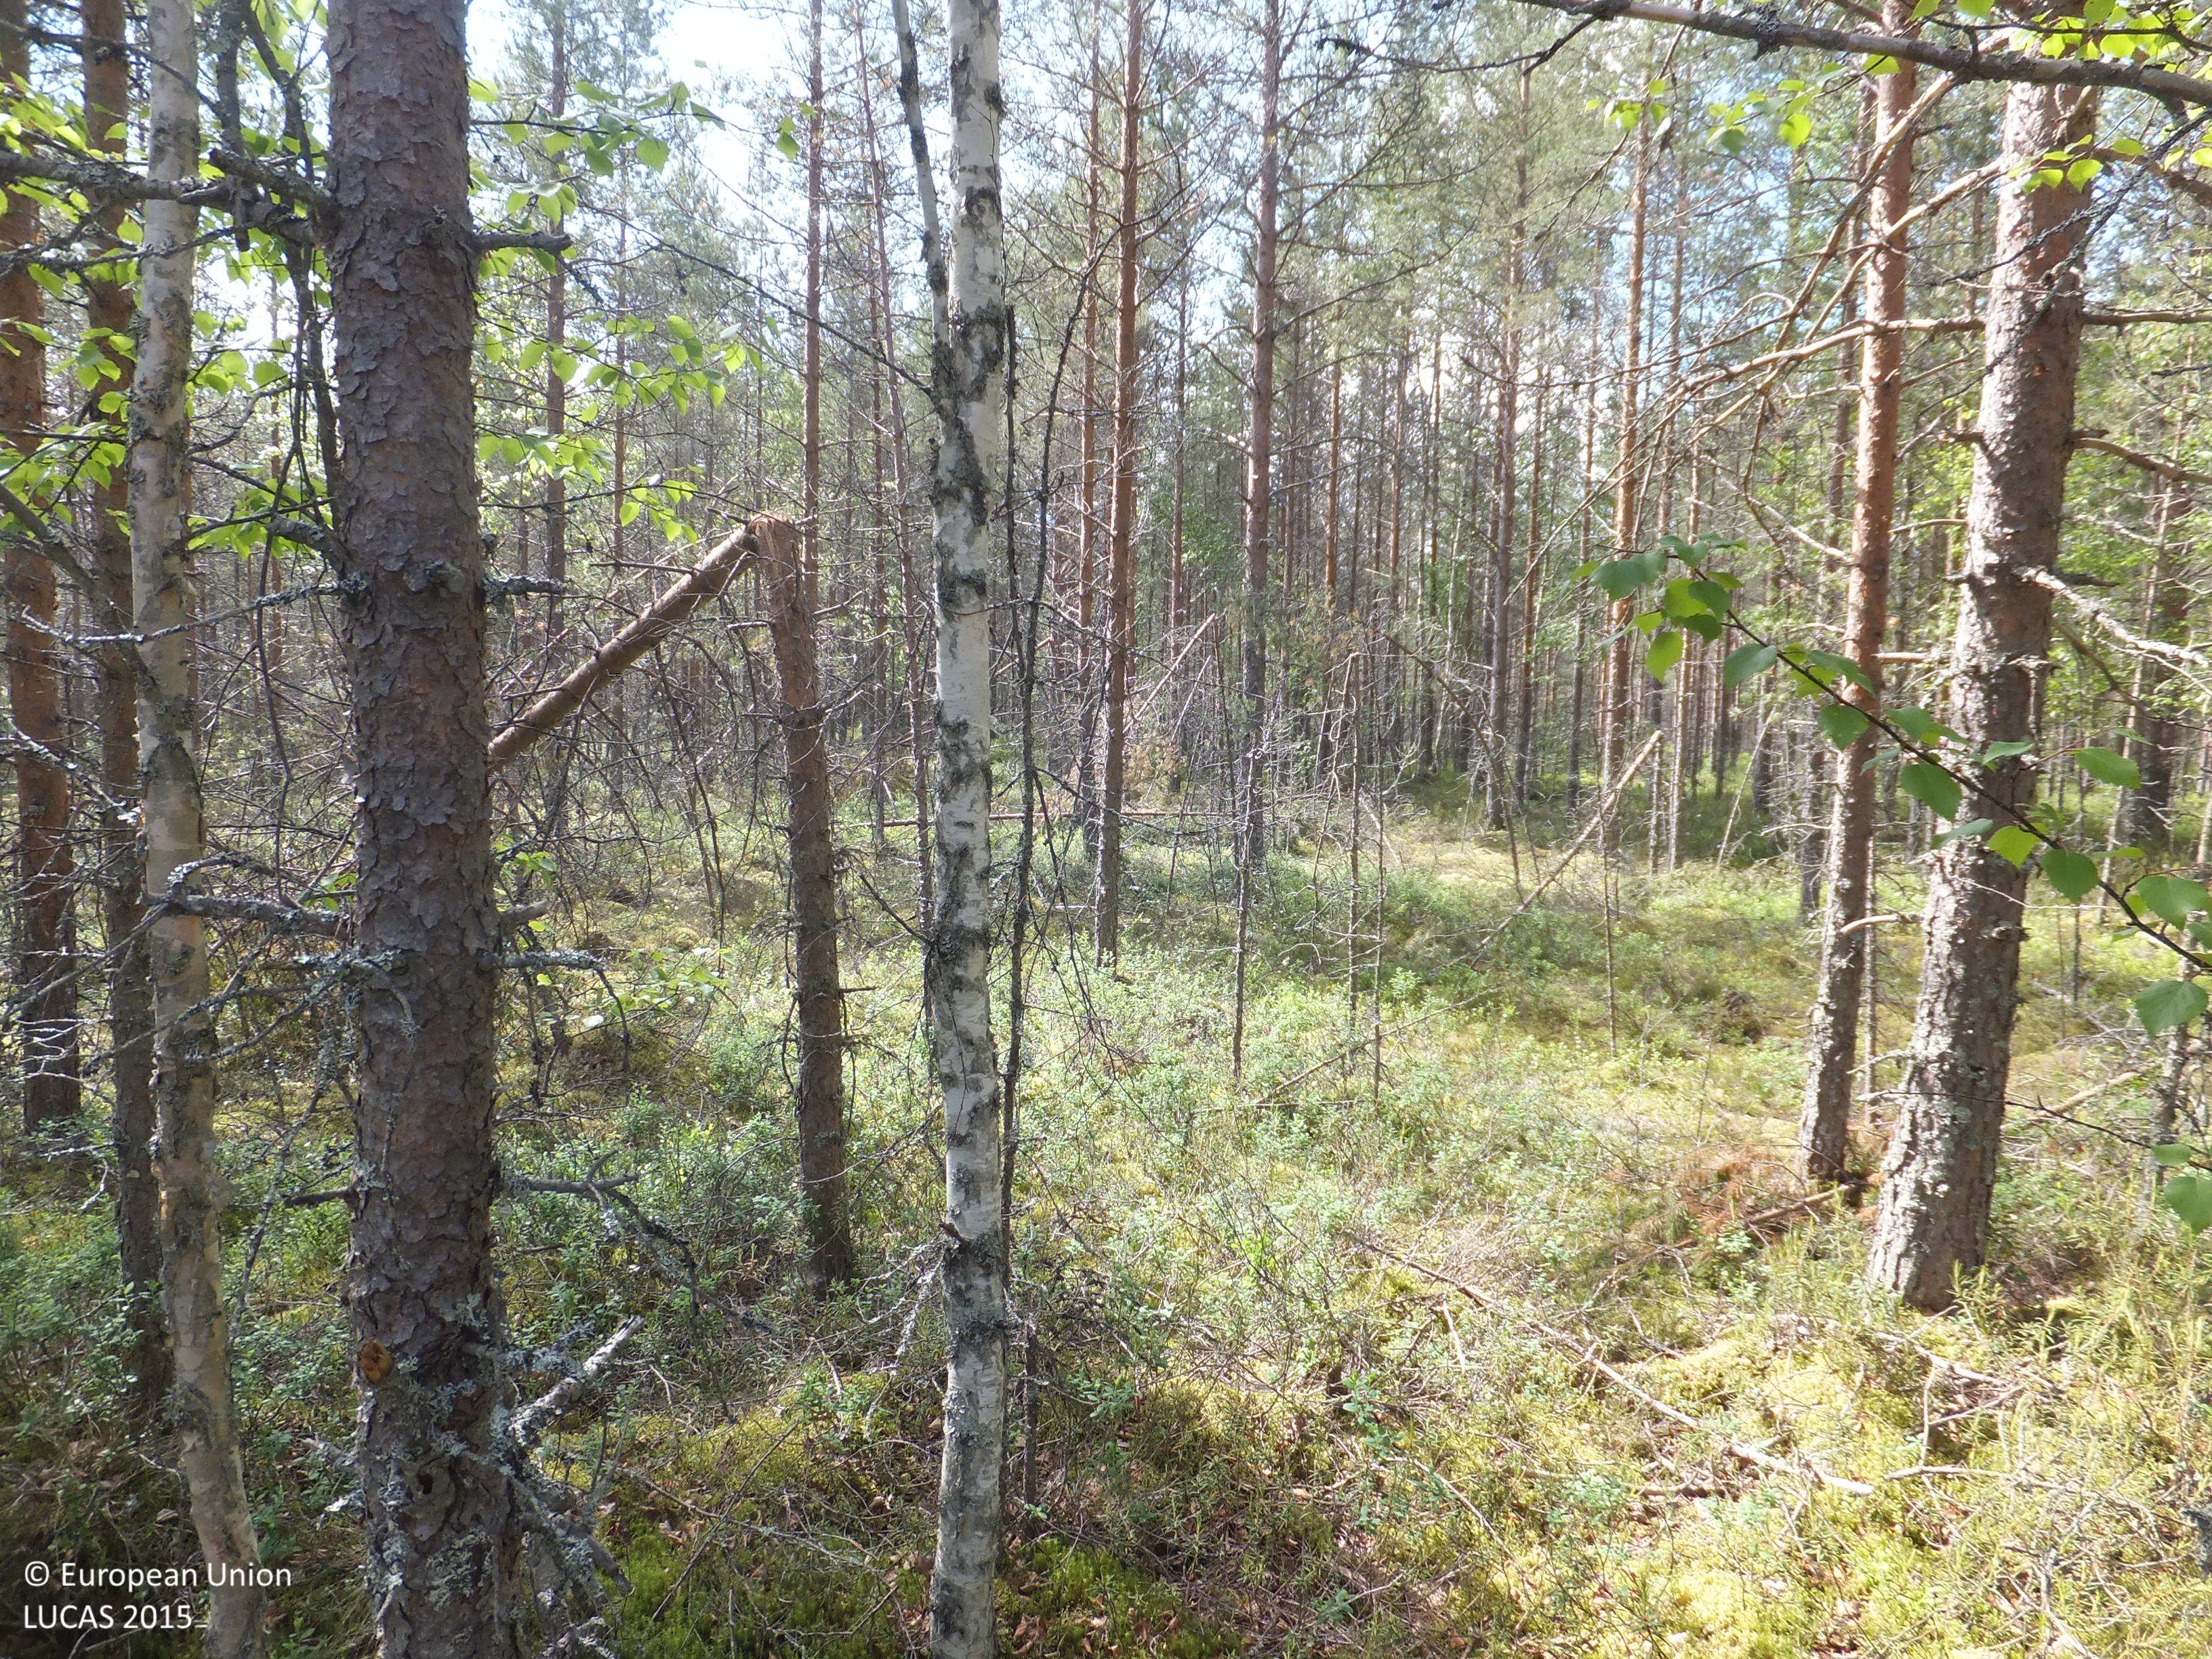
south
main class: Woodland
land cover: Pine dominated coniferous woodland
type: boreal forest
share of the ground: > 75 %
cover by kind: coniferous forest trees 75 %, shrubs 10 %, lichens and mosses 10 %, broadleaved forest trees 5 %
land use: Forestry
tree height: > 5 m
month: June
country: FI
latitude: 63.3354
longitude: 24.3596
